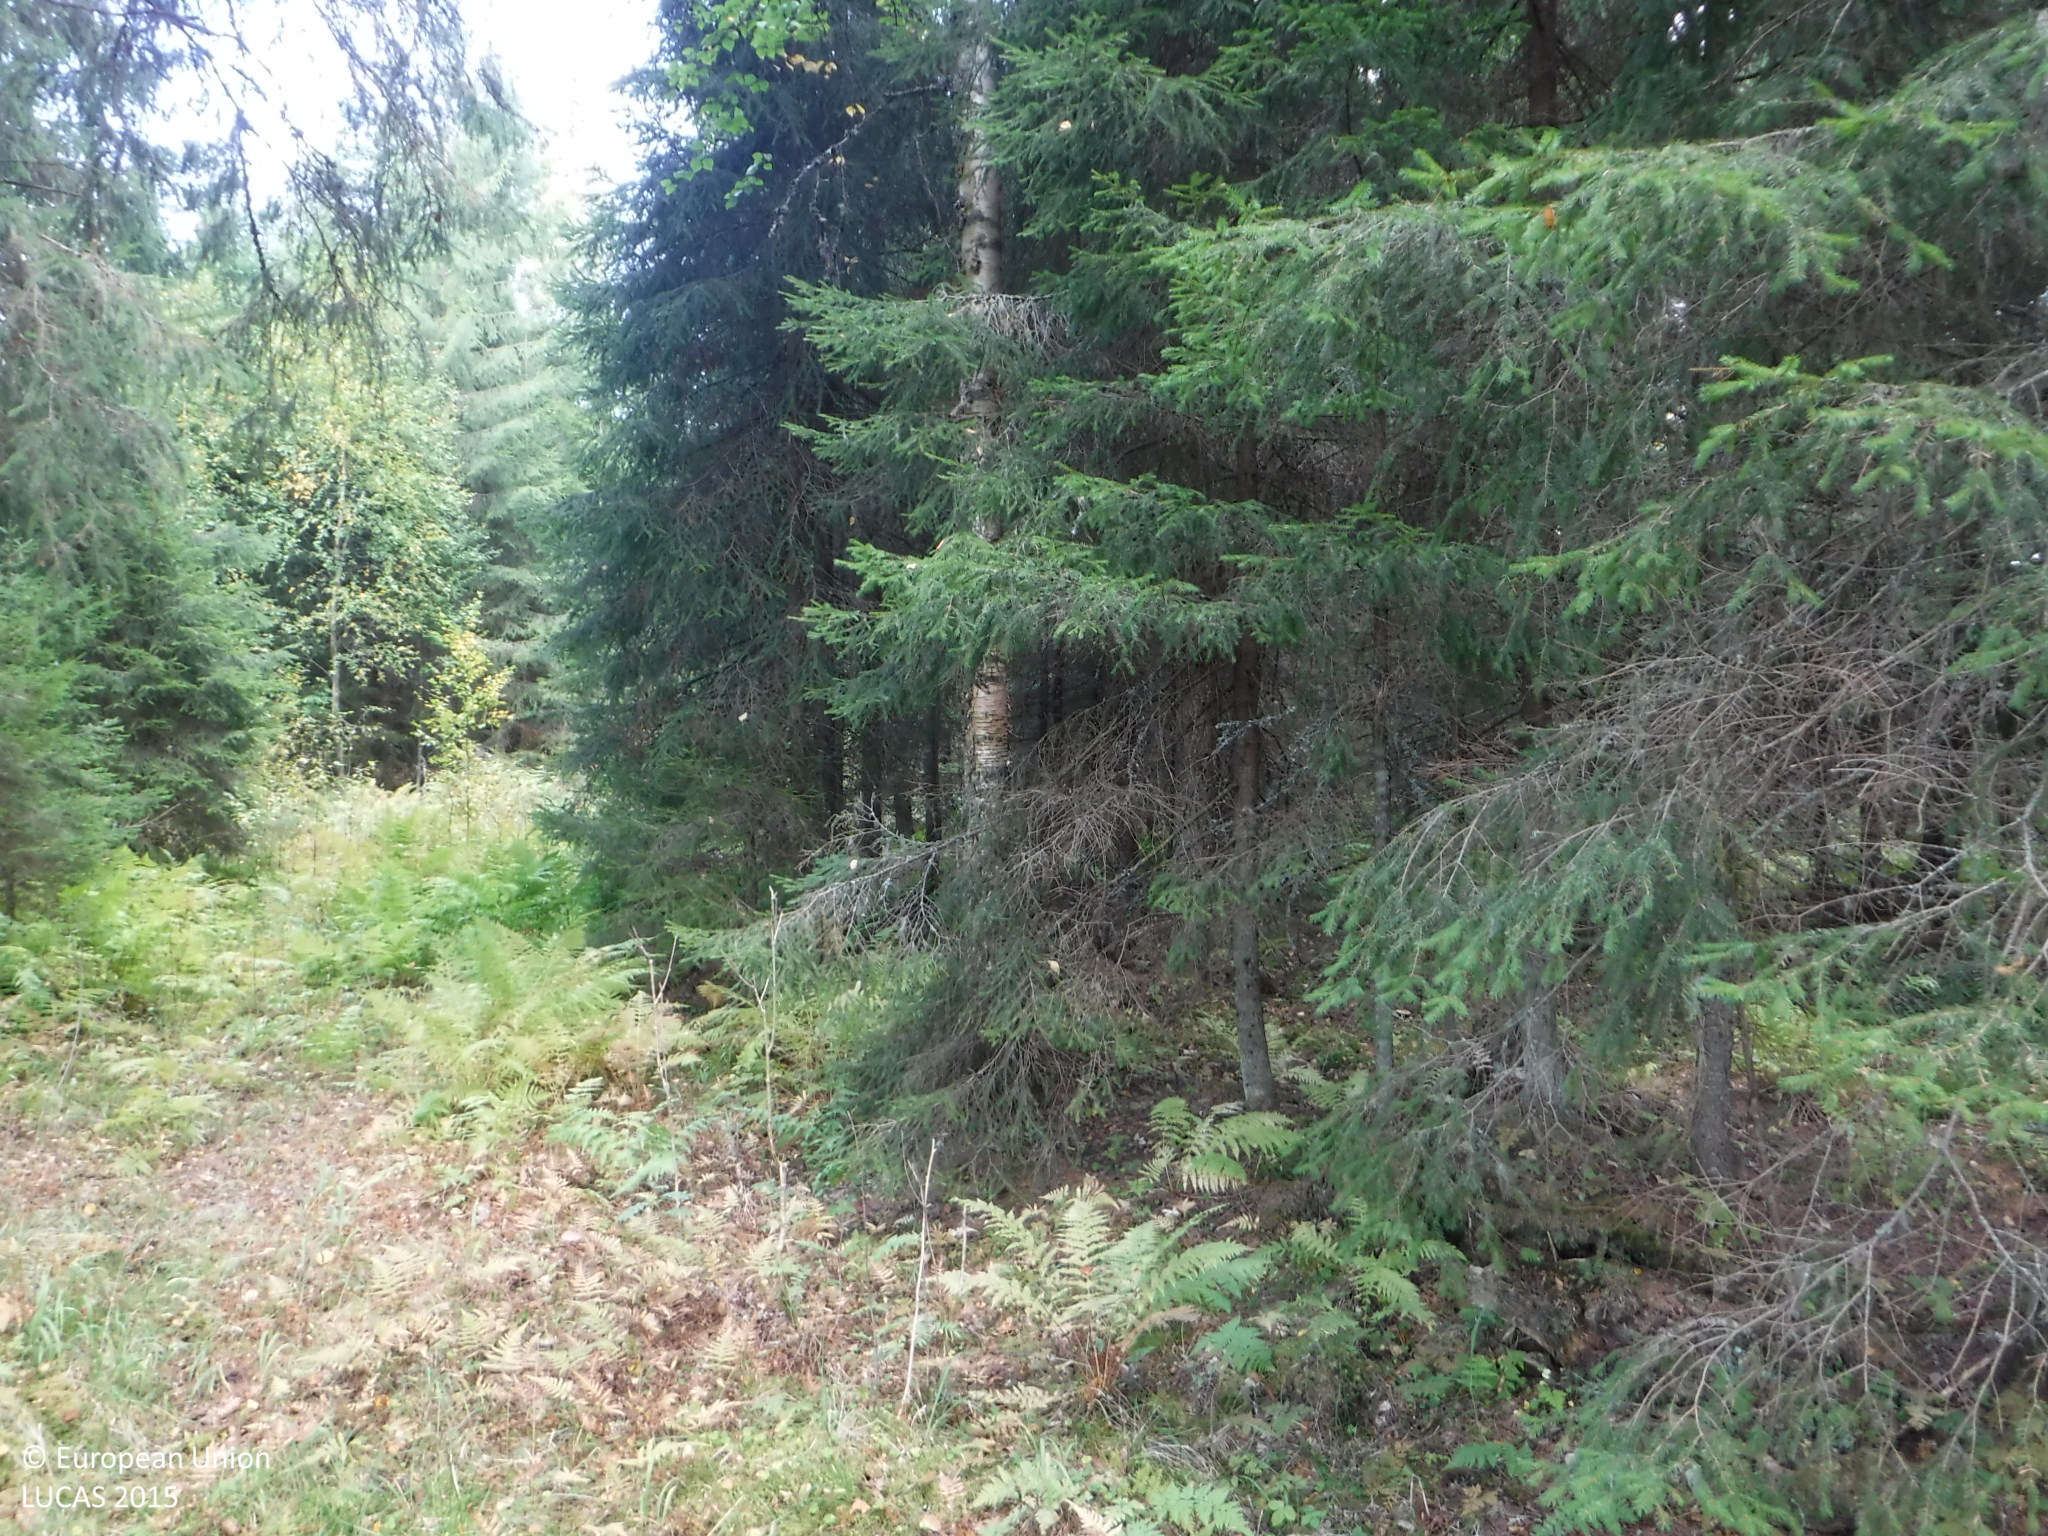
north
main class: Woodland
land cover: Spruce dominated coniferous woodland
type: boreal forest
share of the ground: 50 - 75 %
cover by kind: coniferous forest trees 60 %, herbaceous plants 20 %, broadleaved forest trees 10 %, lichens and mosses 10 %
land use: Forestry
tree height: > 5 m
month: September
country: FI
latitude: 61.7020
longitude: 22.1017
